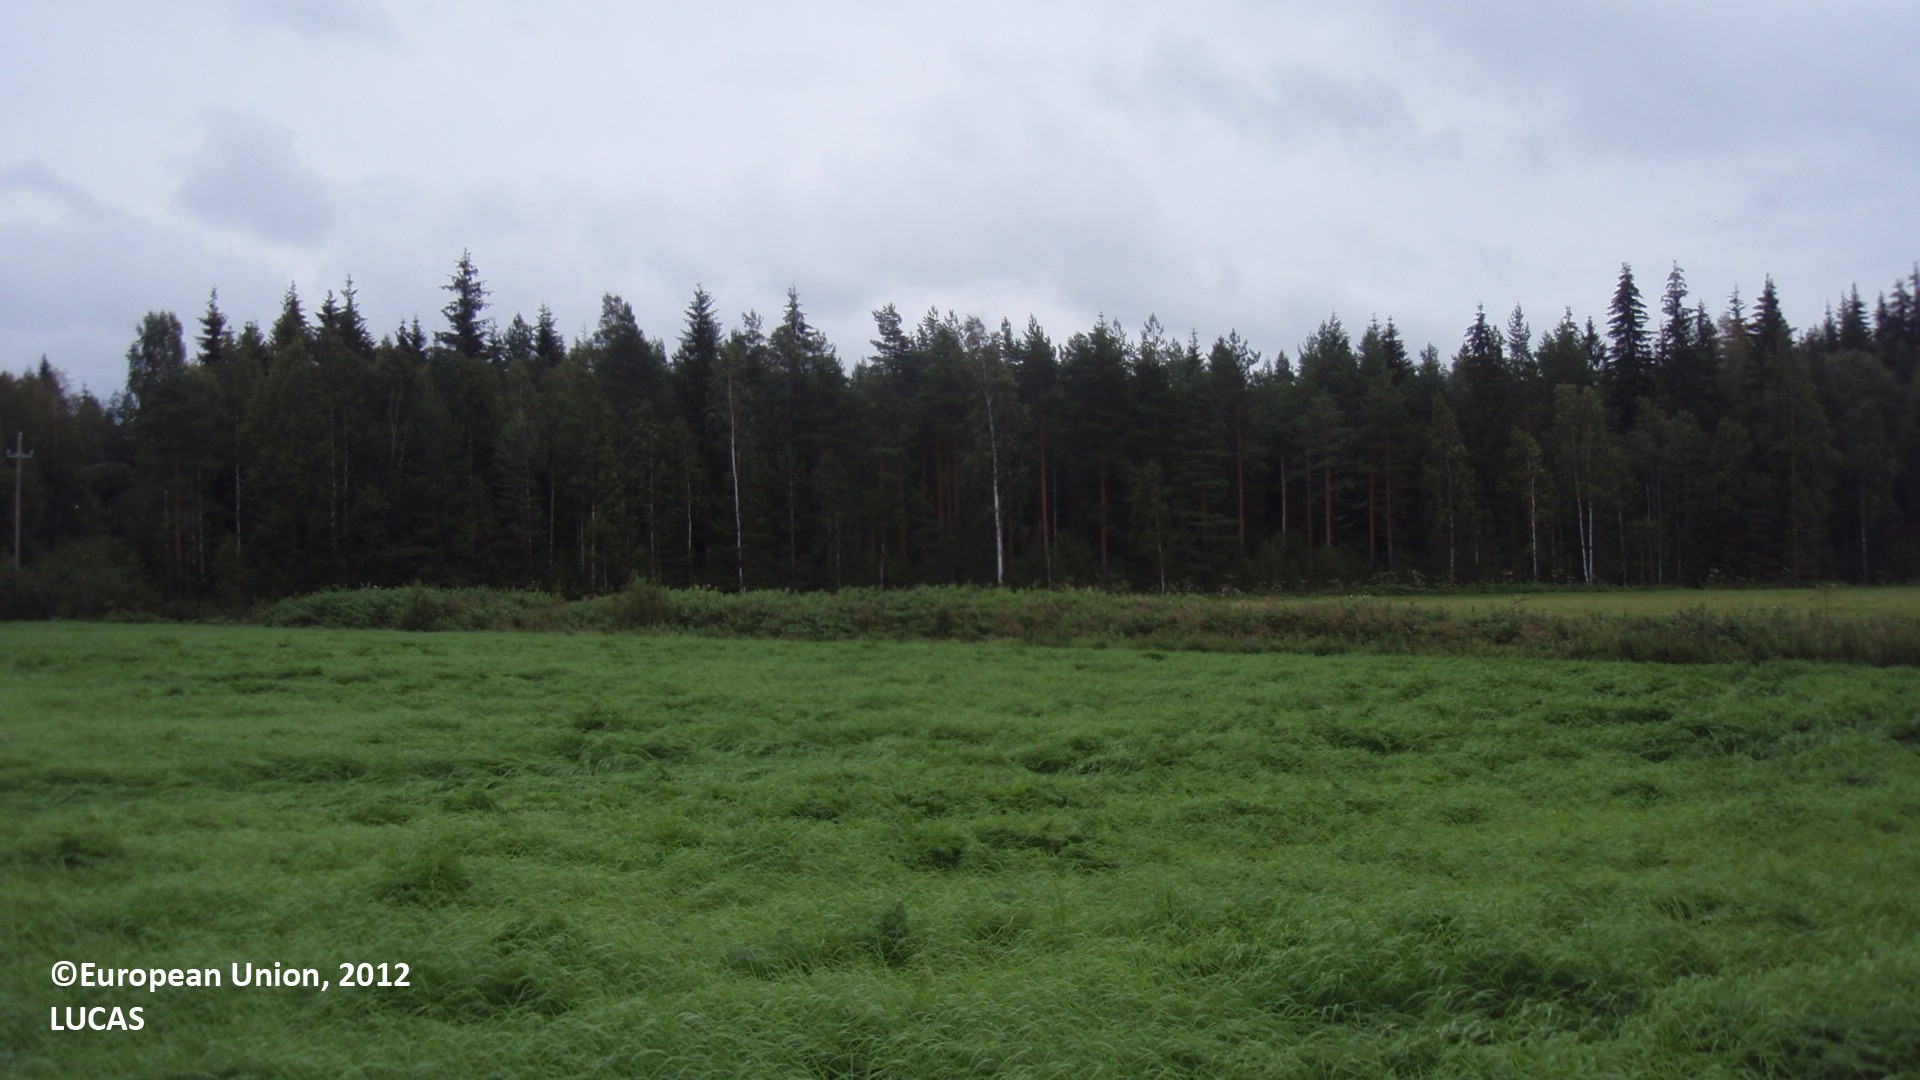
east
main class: Cropland
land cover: Temporary grasslands
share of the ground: > 75 %
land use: Agriculture (excluding fallow land and kitchen gardens)
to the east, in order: Temporary grasslands; Ditches and canals; Shrubland with sparse tree cover; Pine dominated mixed woodland
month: August
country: FI
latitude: 61.0854
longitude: 27.0963
